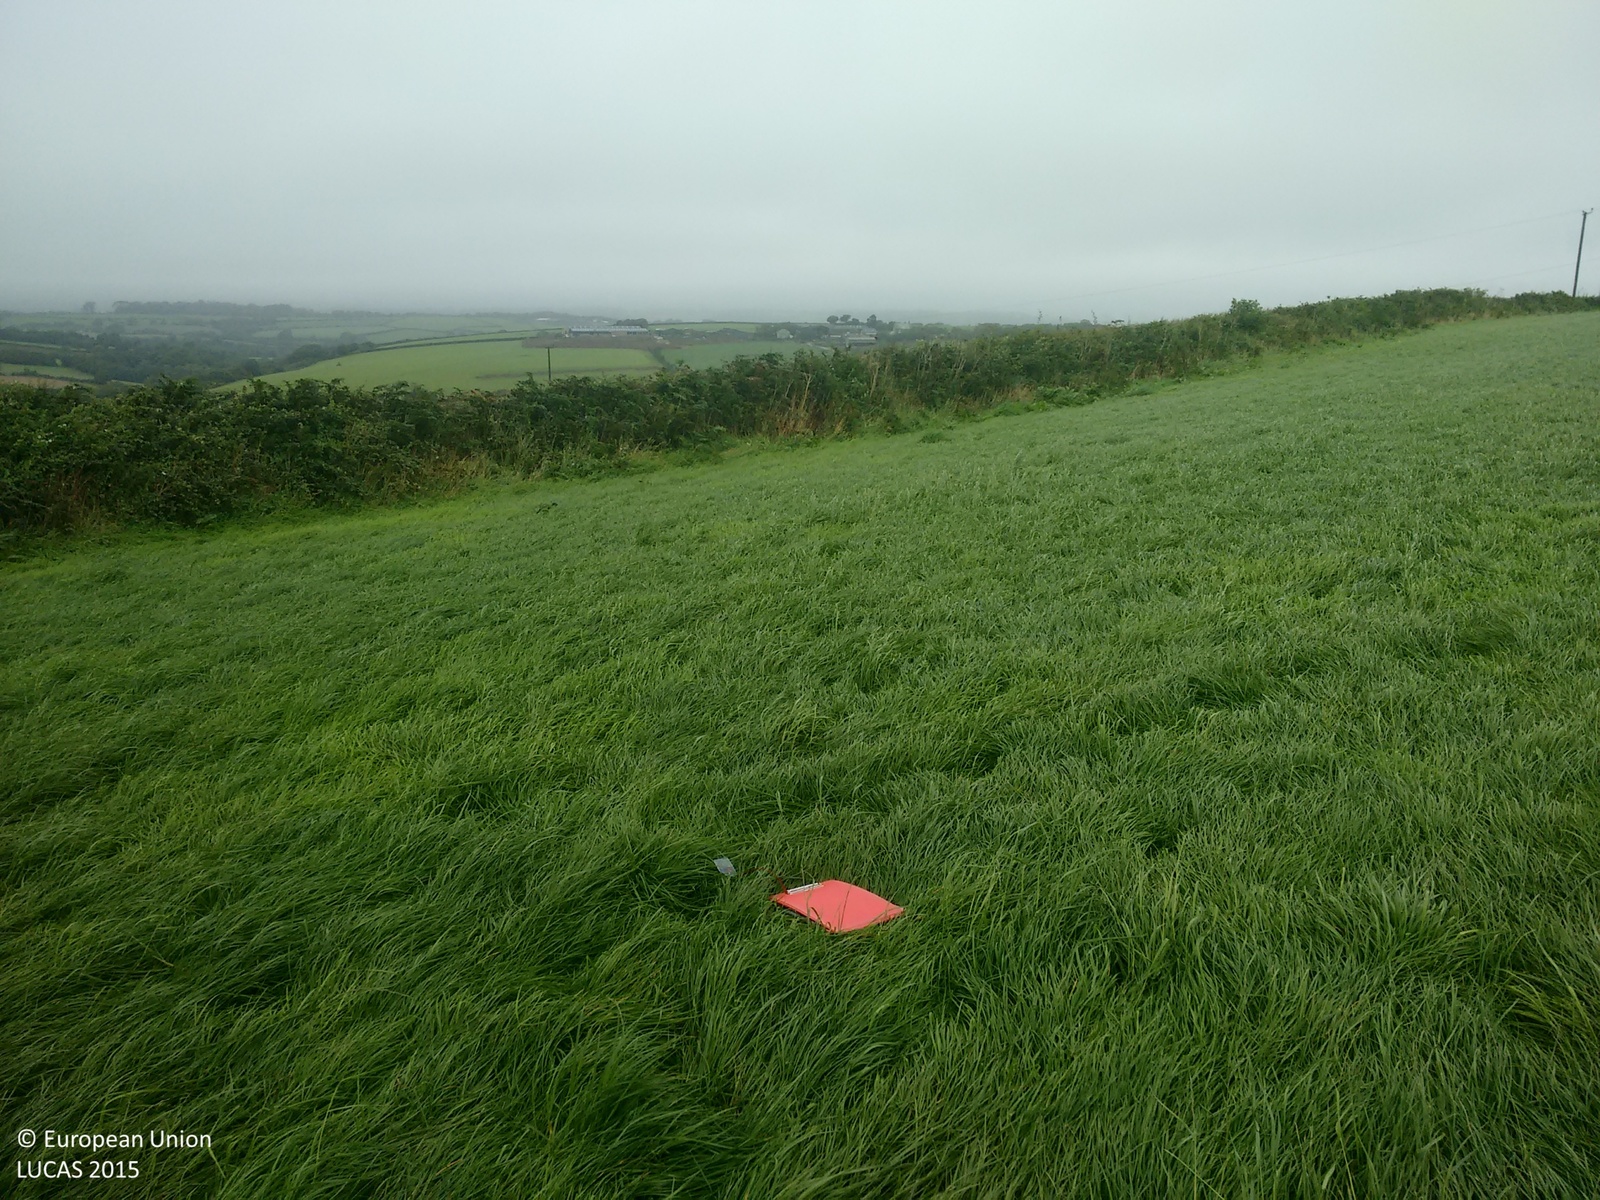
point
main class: Grassland
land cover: Grassland without tree/shrub cover
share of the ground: > 75 %
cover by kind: herbaceous plants 100 %
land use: Agriculture (excluding fallow land and kitchen gardens)
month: August
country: GB
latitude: 50.0665
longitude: -5.1080
